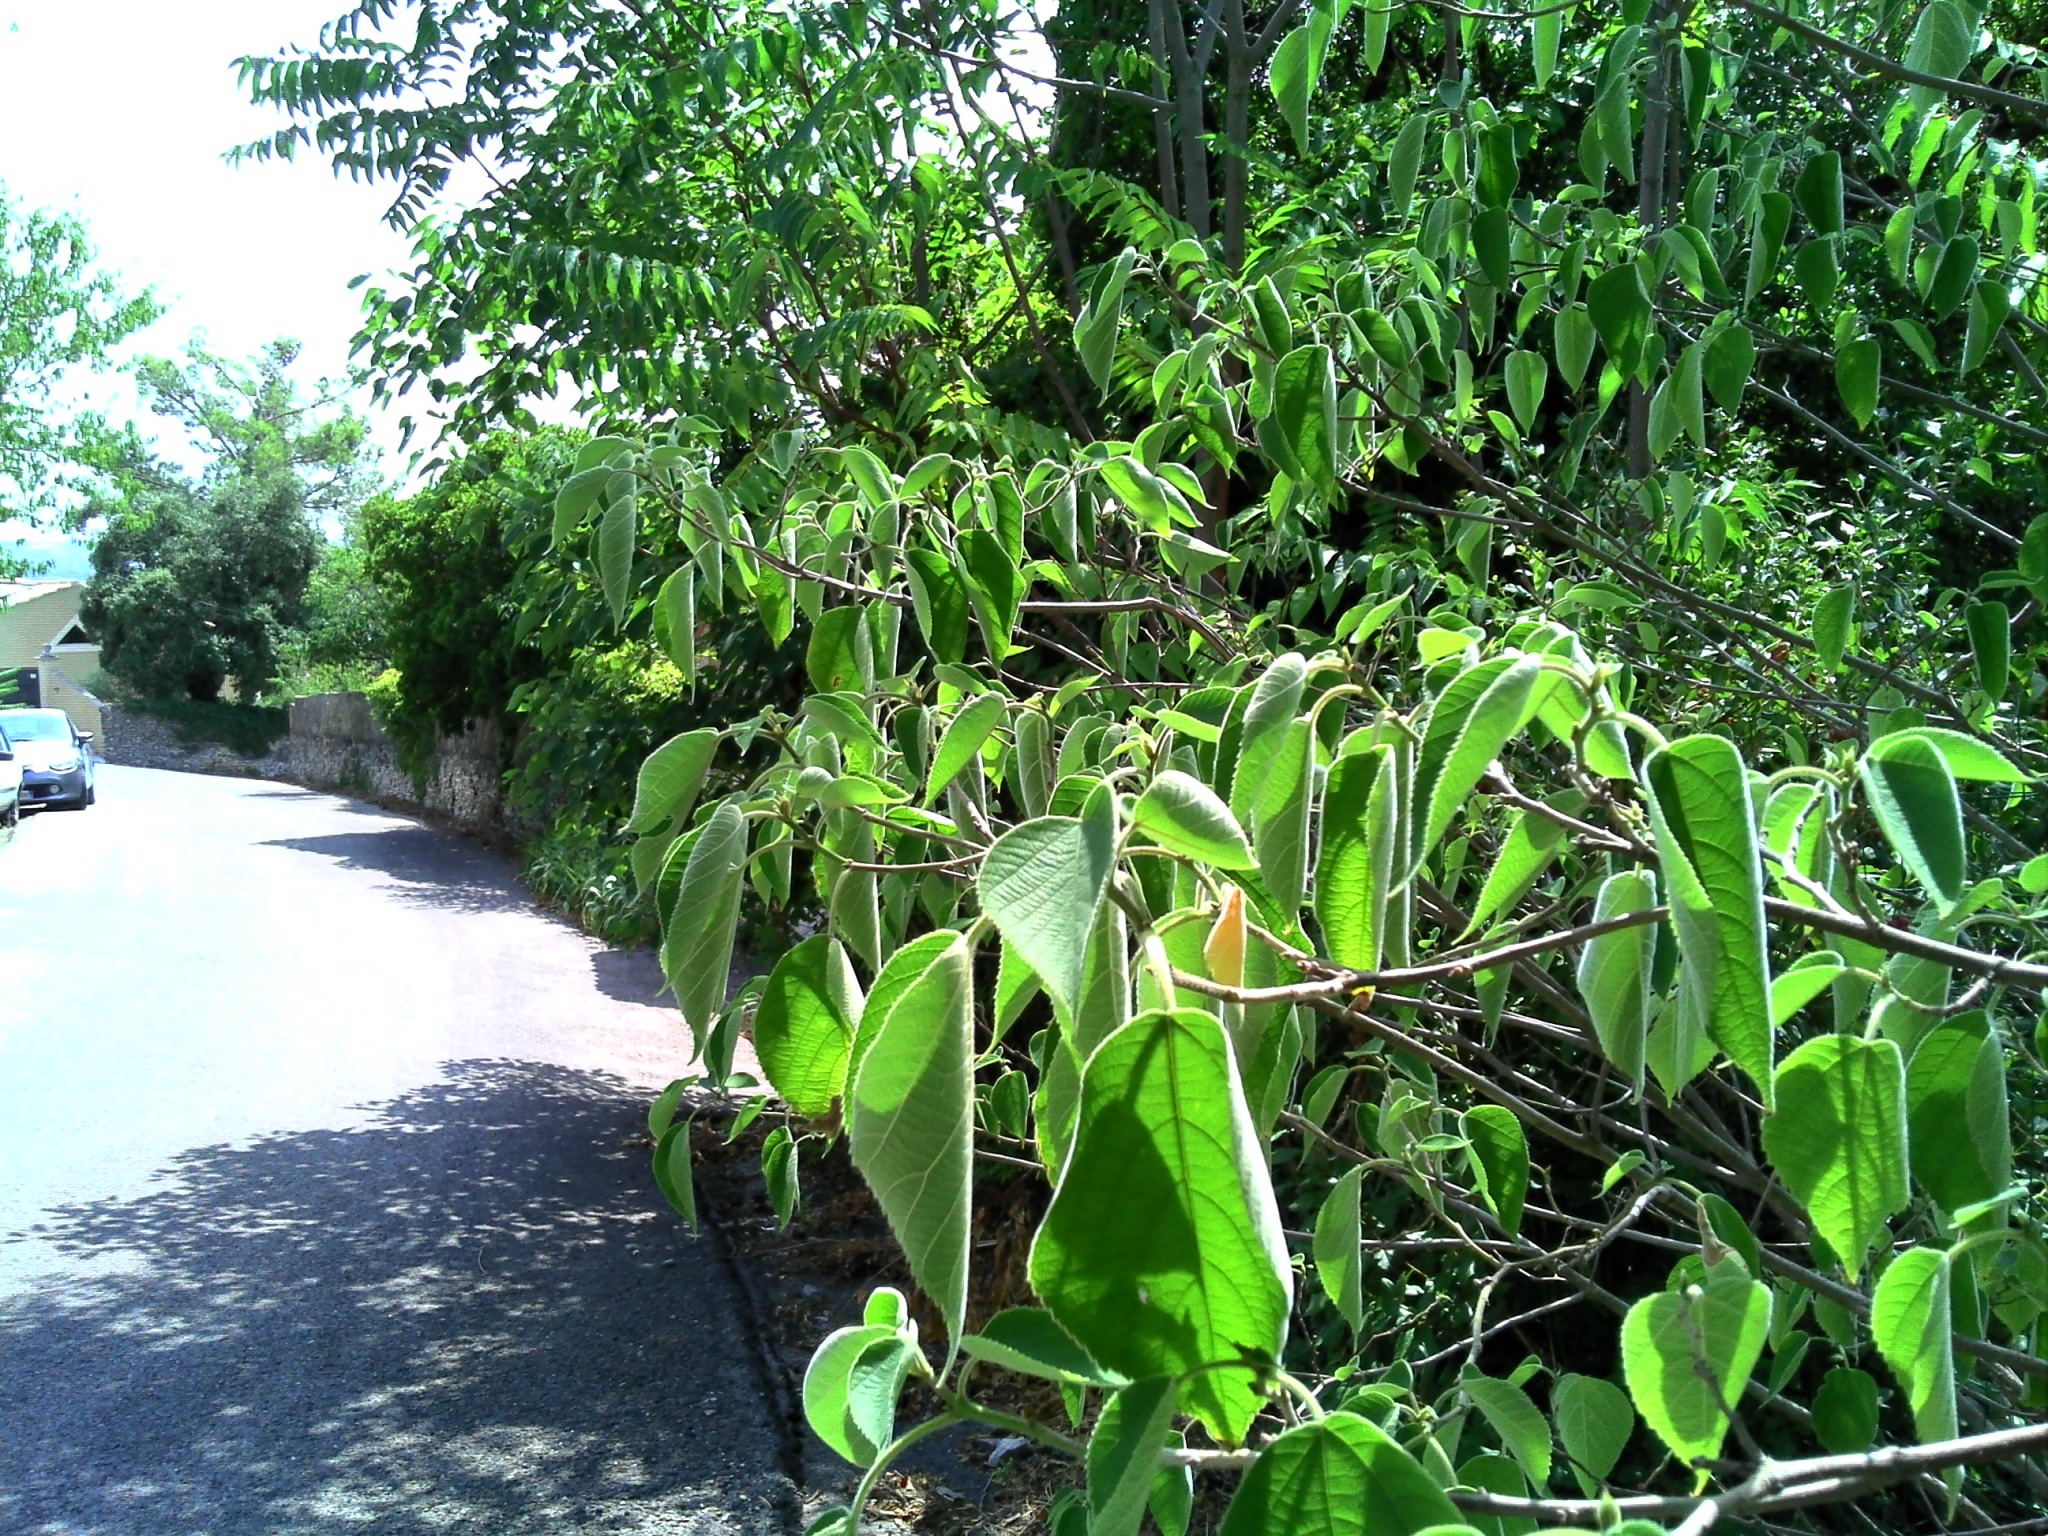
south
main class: Woodland
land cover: Pine dominated mixed woodland
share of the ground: 50 - 75 %
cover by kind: coniferous forest trees 30 %, broadleaved forest trees 30 %, herbaceous plants 20 %, consolidated bare surface 20 %
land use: Residential
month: August
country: FR
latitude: 43.8544
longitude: 4.3732
